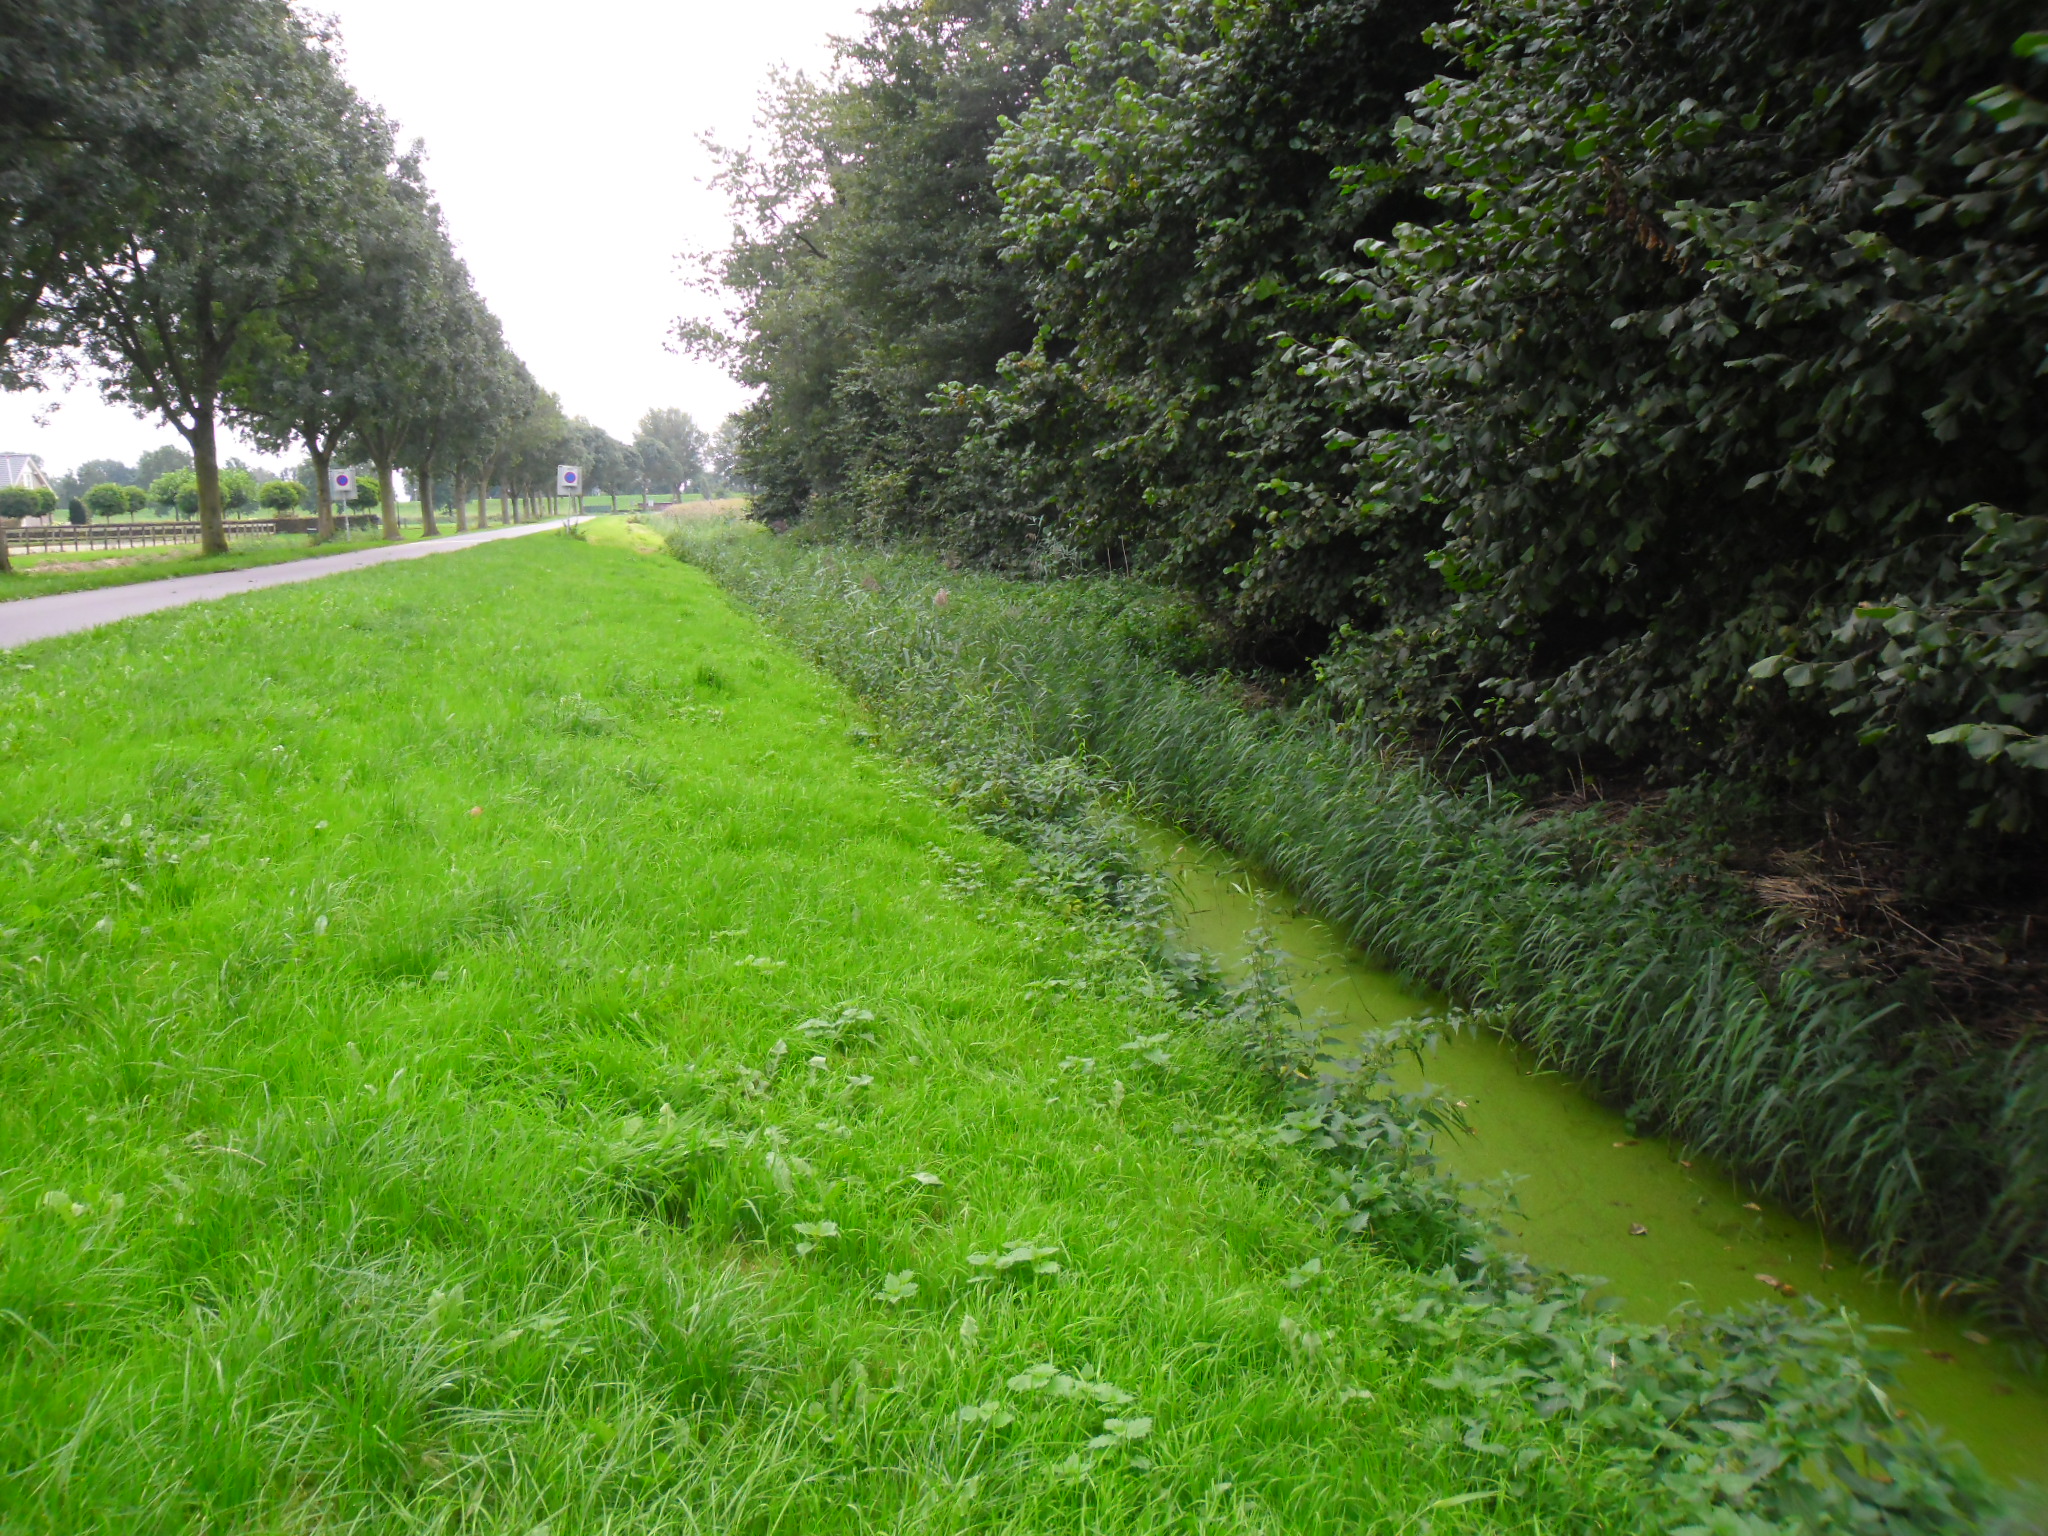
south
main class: Woodland
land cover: Broadleaved woodland
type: mesophytic deciduous forest
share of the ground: > 75 %
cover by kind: broadleaved forest trees 100 %
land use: Semi-natural and natural areas not in use
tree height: > 5 m
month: September
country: NL
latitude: 52.2742
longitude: 5.4991
